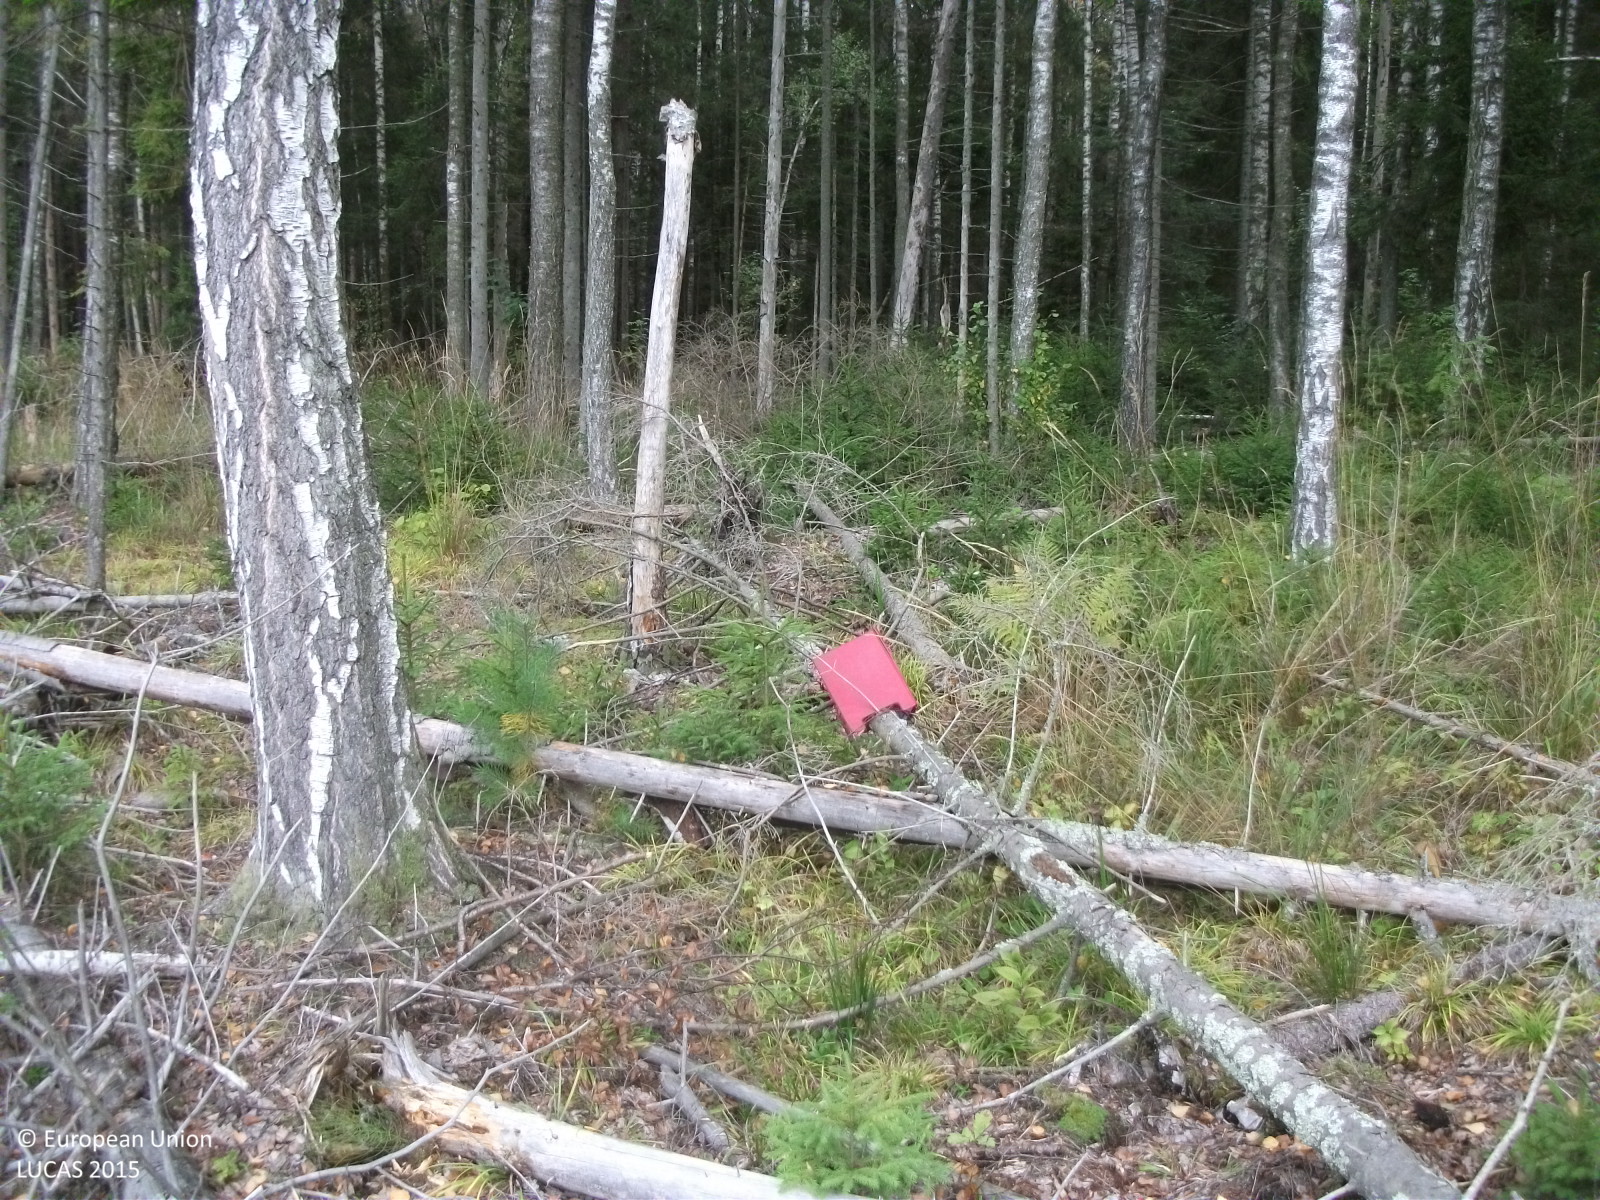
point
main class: Woodland
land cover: Spruce dominated mixed woodland
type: hemiboreal forest and nemoral coniferous forest and mixed broadleaved-coniferous forest
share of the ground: > 75 %
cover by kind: coniferous forest trees 50 %, broadleaved forest trees 30 %, herbaceous plants 10 %, shrubs 5 %
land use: Forestry
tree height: > 5 m
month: September
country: LV
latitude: 57.7826
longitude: 24.4332
